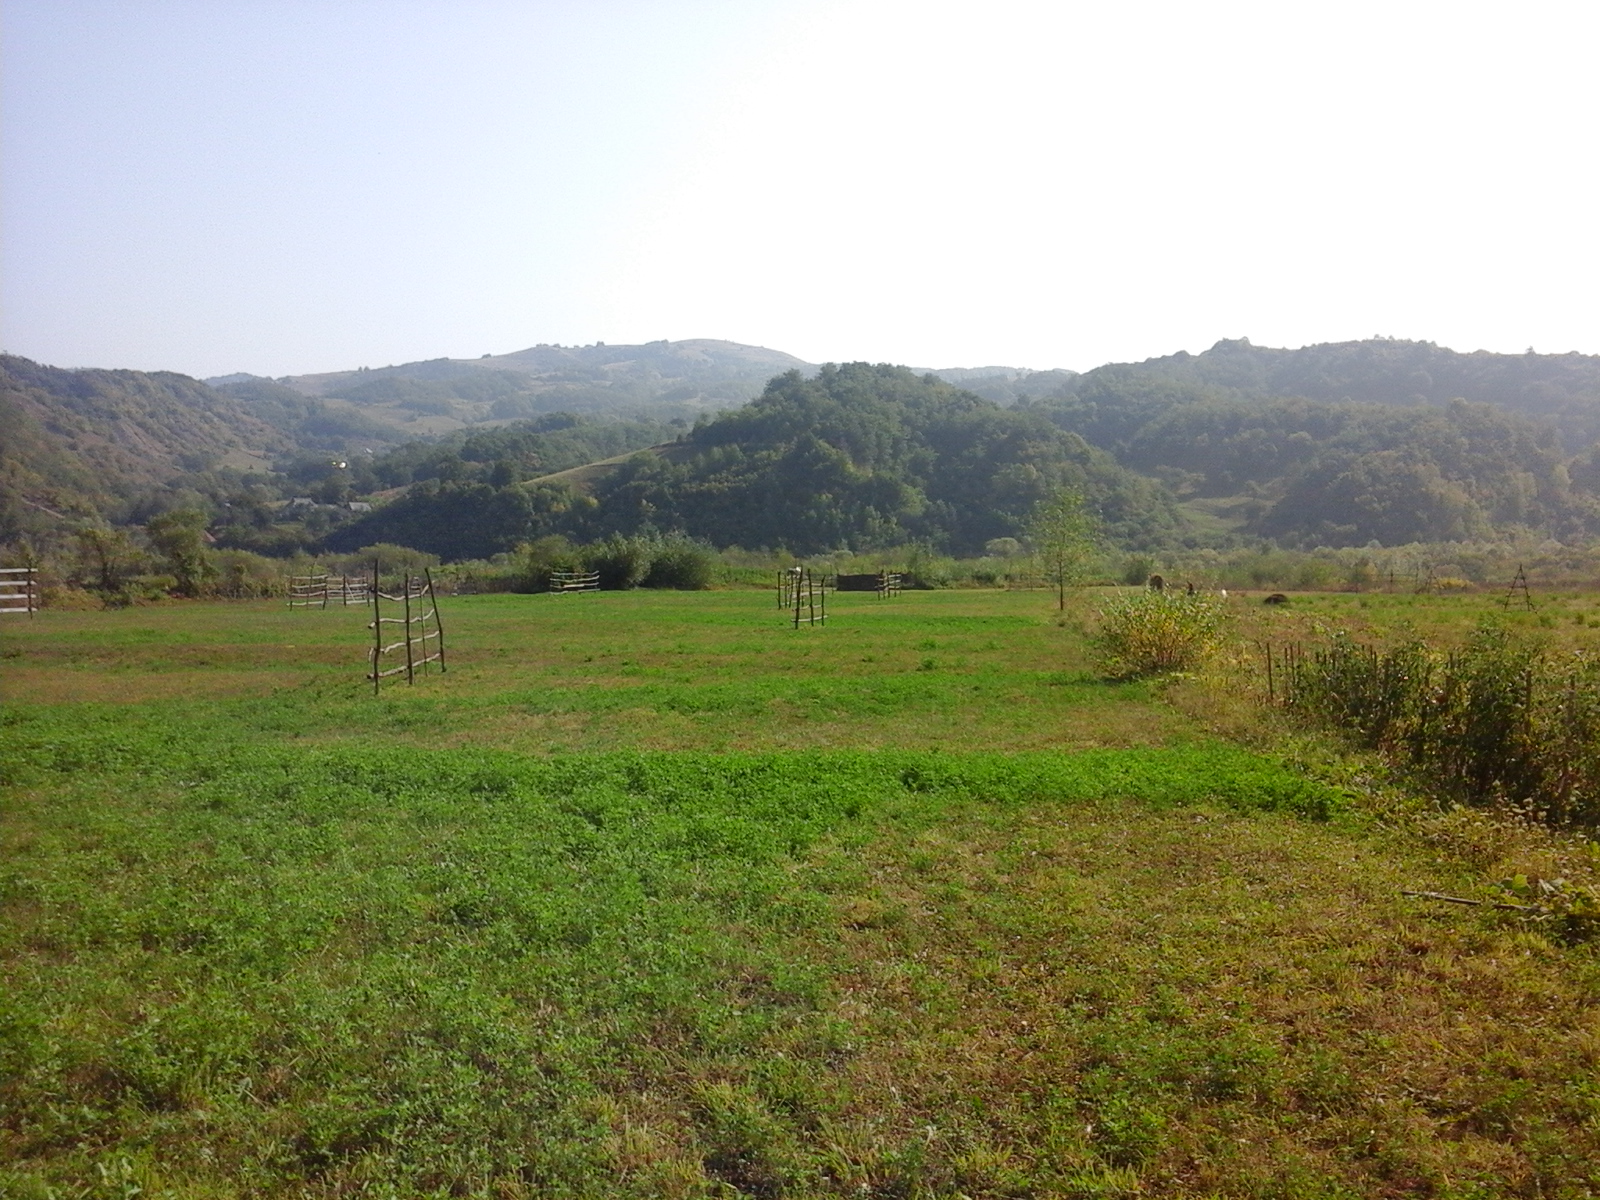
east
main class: Cropland
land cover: Lucerne
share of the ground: > 75 %
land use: Agriculture (excluding fallow land and kitchen gardens)
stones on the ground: < 10 %
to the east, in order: Lucerne; Grassland without tree/shrub cover; Other fresh vegetables; Grassland without tree/shrub cover; Abandoned hedges; Lucerne; Shrubland without tree cover; Inland fresh running water
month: September
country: RO
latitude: 47.7144
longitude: 24.2317
